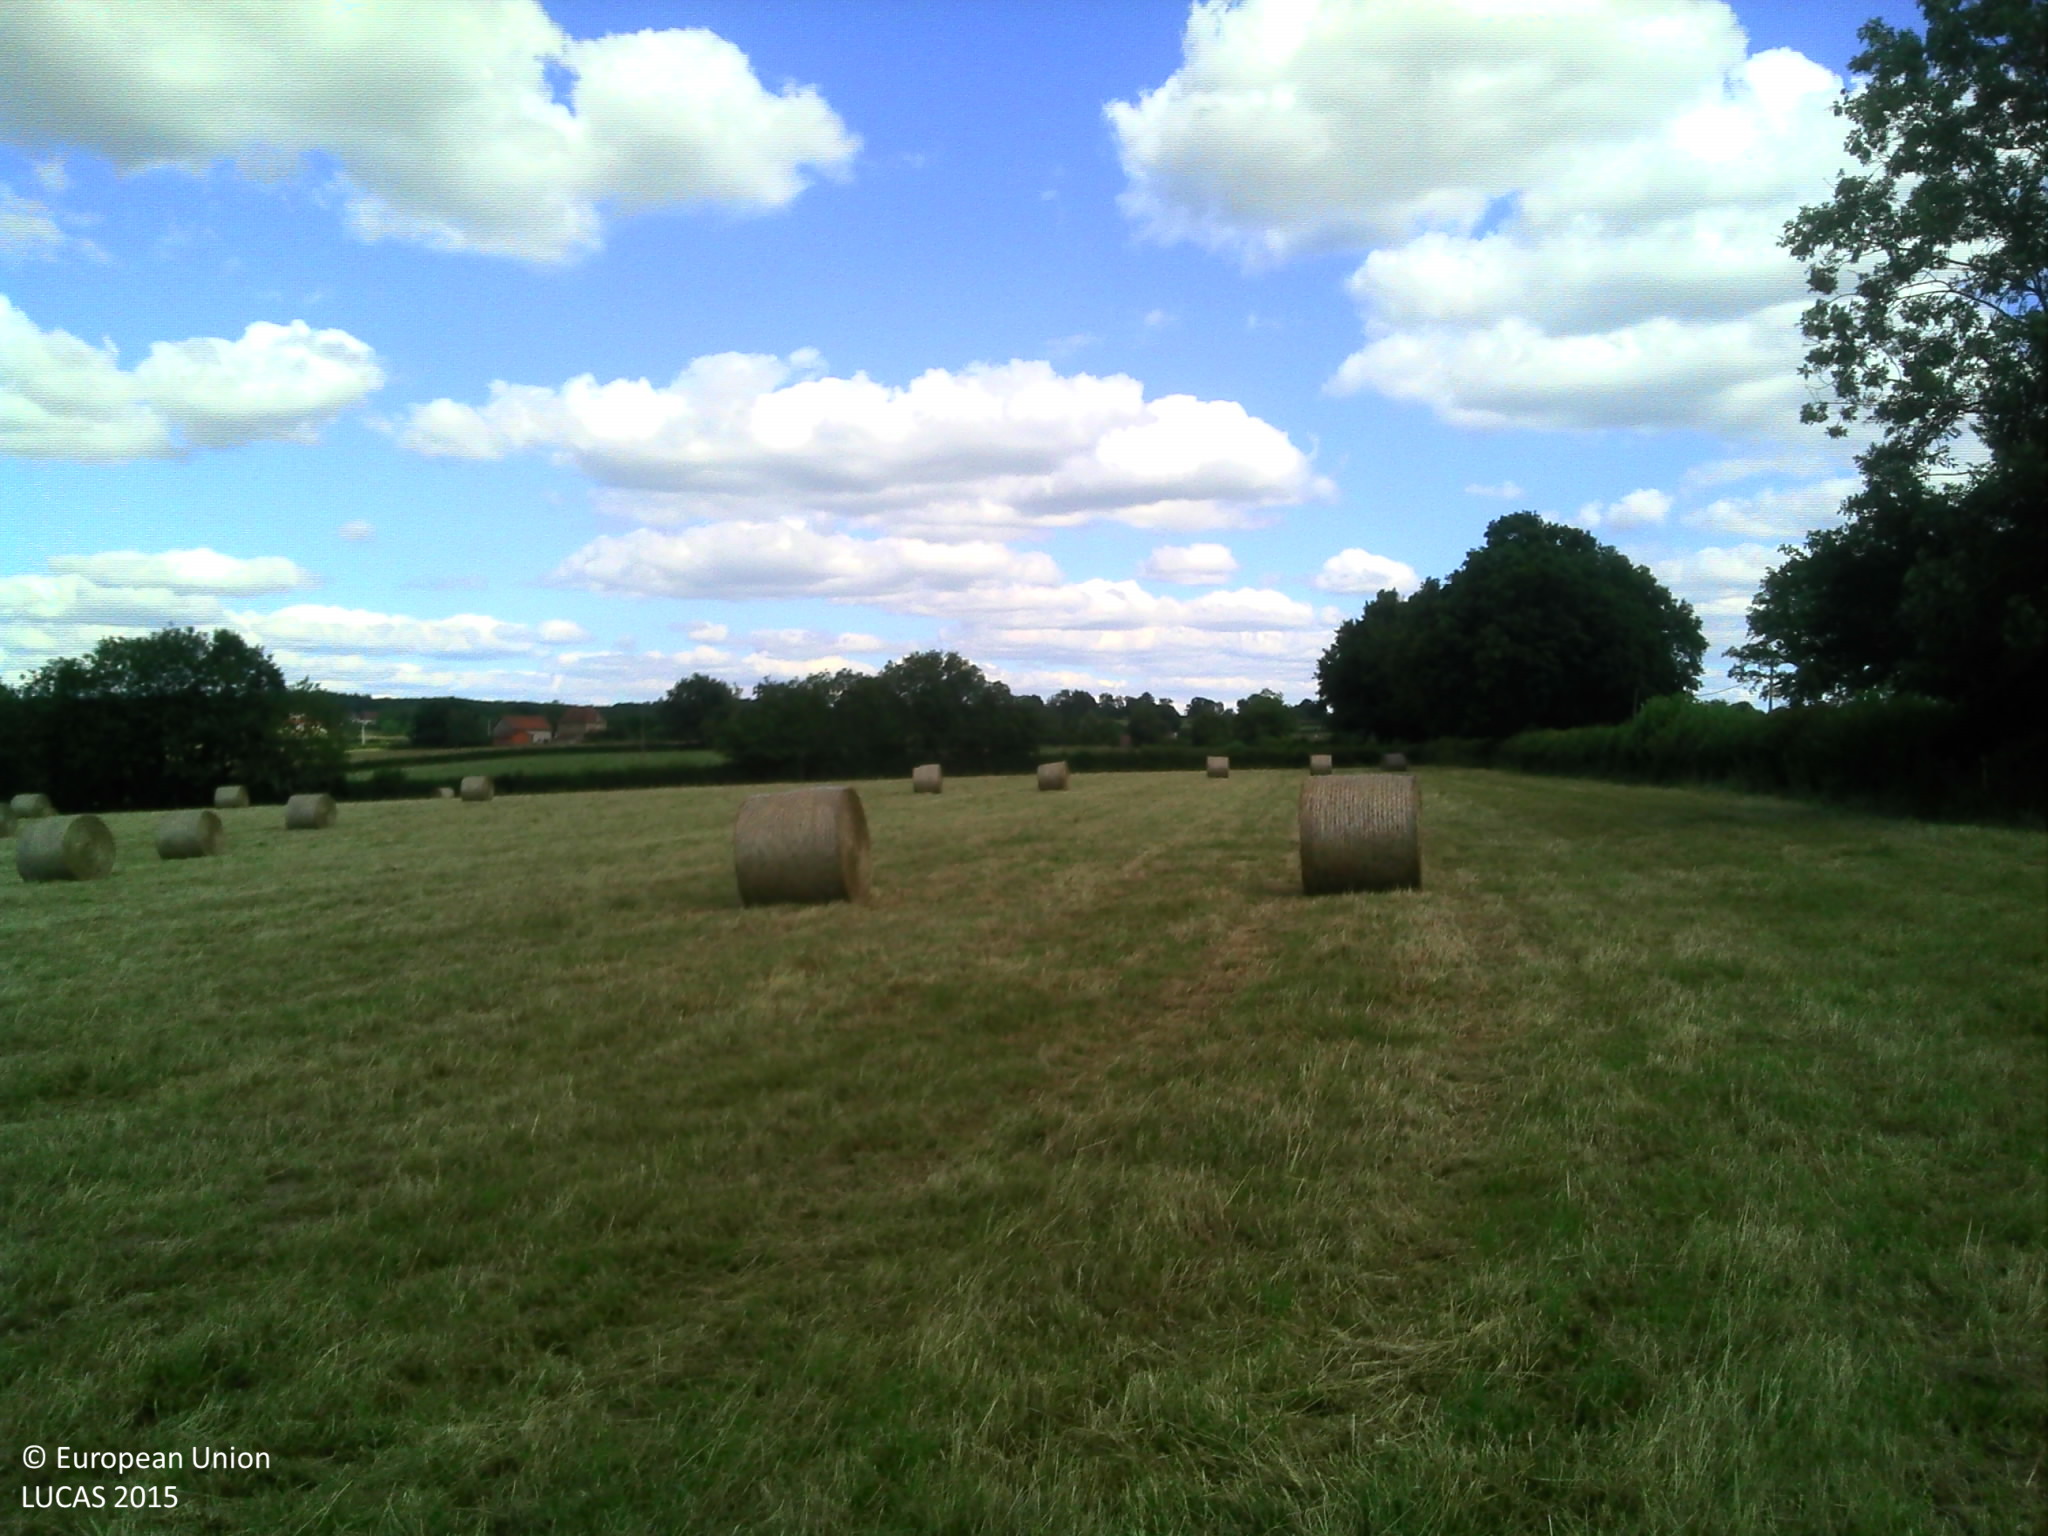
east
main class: Grassland
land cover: Grassland without tree/shrub cover
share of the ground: > 75 %
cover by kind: herbaceous plants 100 %
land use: Agriculture (excluding fallow land and kitchen gardens)
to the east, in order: Grassland without tree/shrub cover; Fences; Managed hedges; Grassland without tree/shrub cover
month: June
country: FR
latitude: 46.2397
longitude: 4.0485
